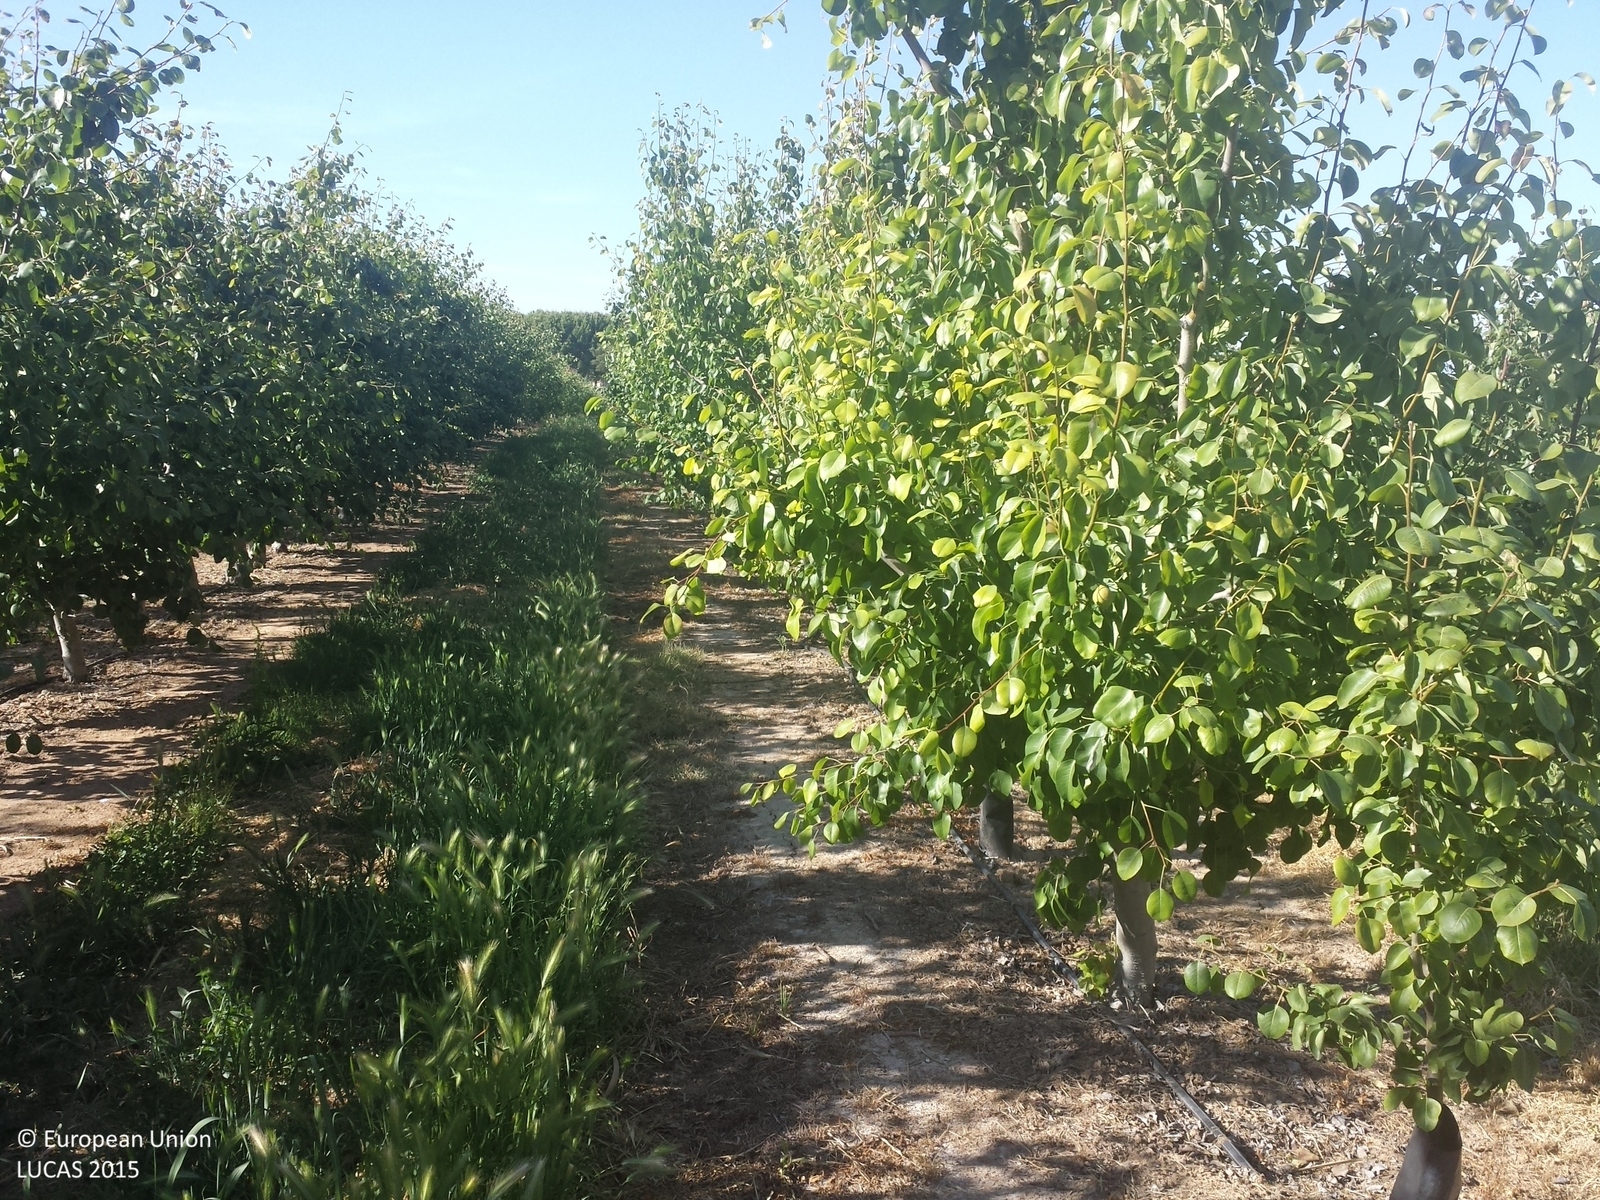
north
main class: Cropland
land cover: Pear fruit
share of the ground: 25 - 50 %
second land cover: Grassland without tree/shrub cover
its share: 50 - 75 %
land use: Agriculture (excluding fallow land and kitchen gardens)
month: May
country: ES
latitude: 41.6512
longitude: 0.5854
